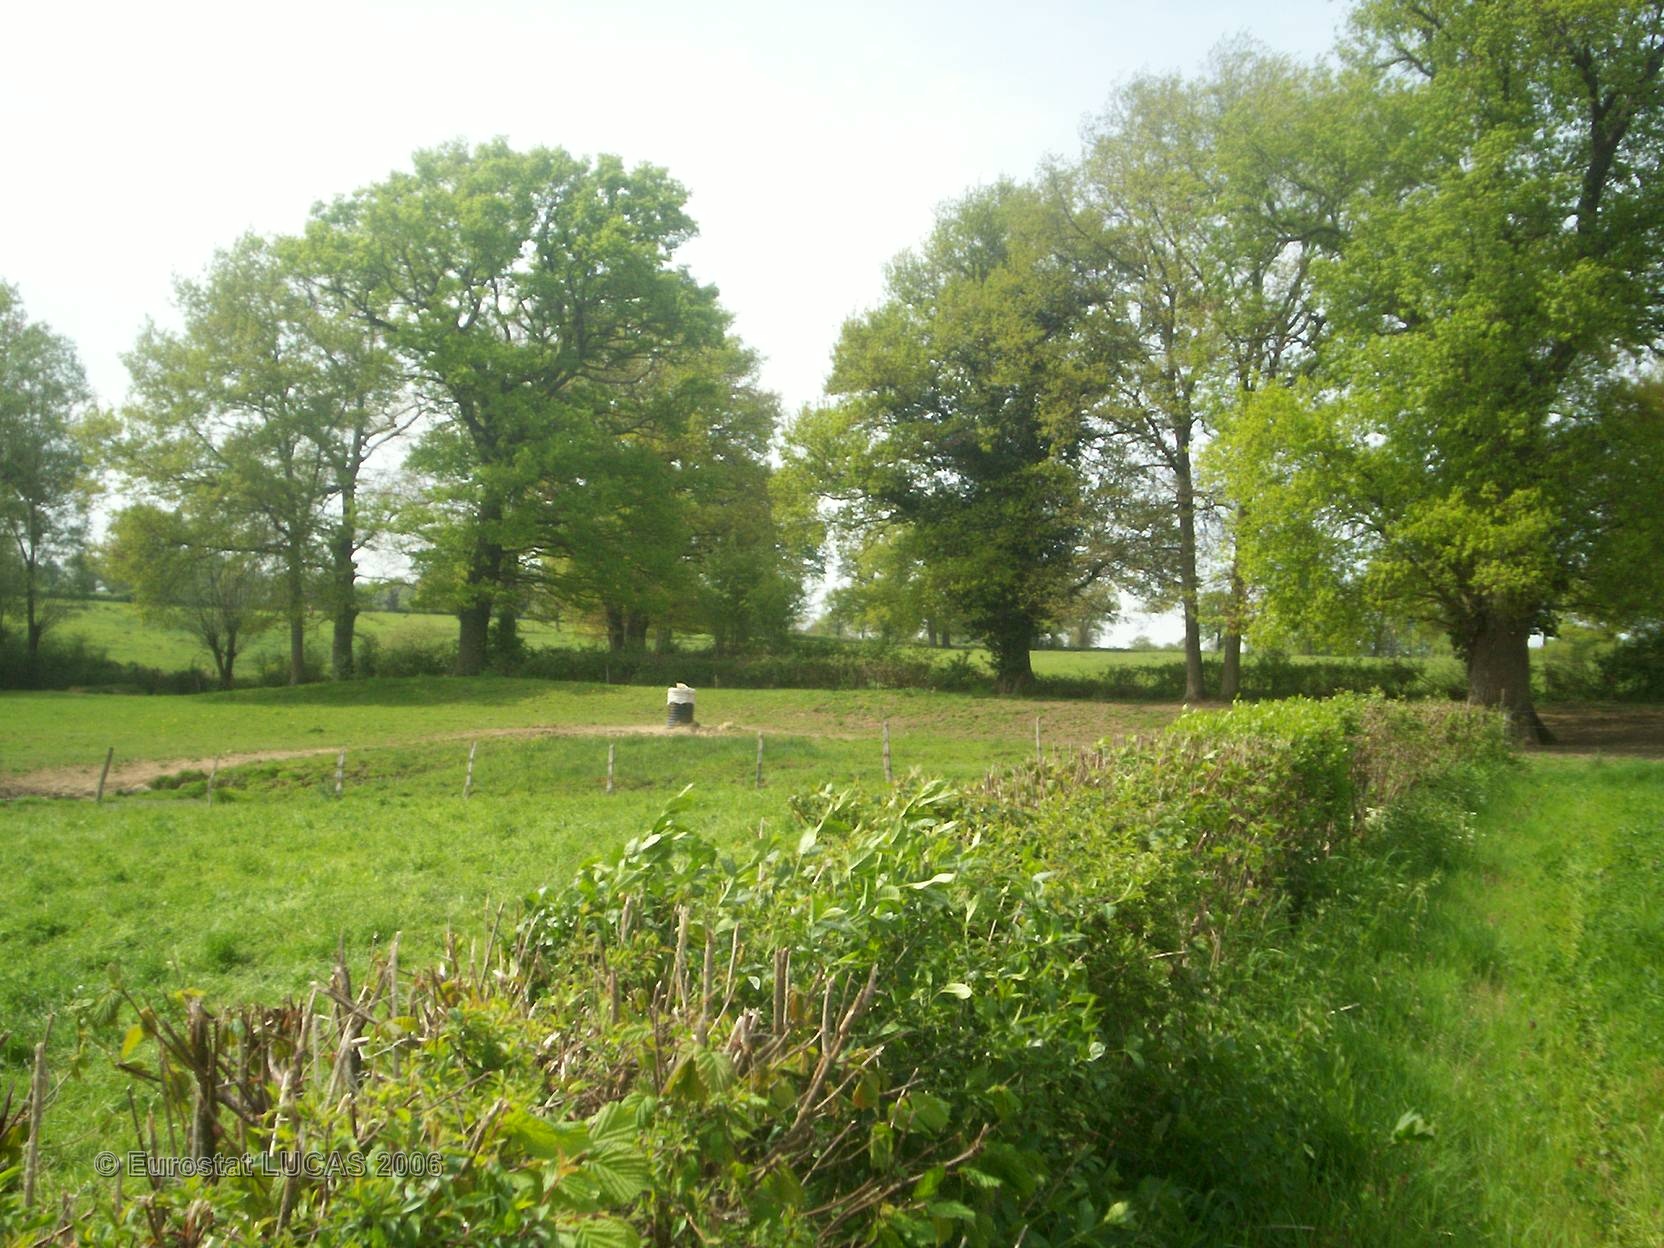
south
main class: Grassland
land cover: Grassland without tree/shrub cover
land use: Agriculture (excluding fallow land and kitchen gardens)
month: May
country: FR
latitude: 46.5635
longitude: 3.1225
